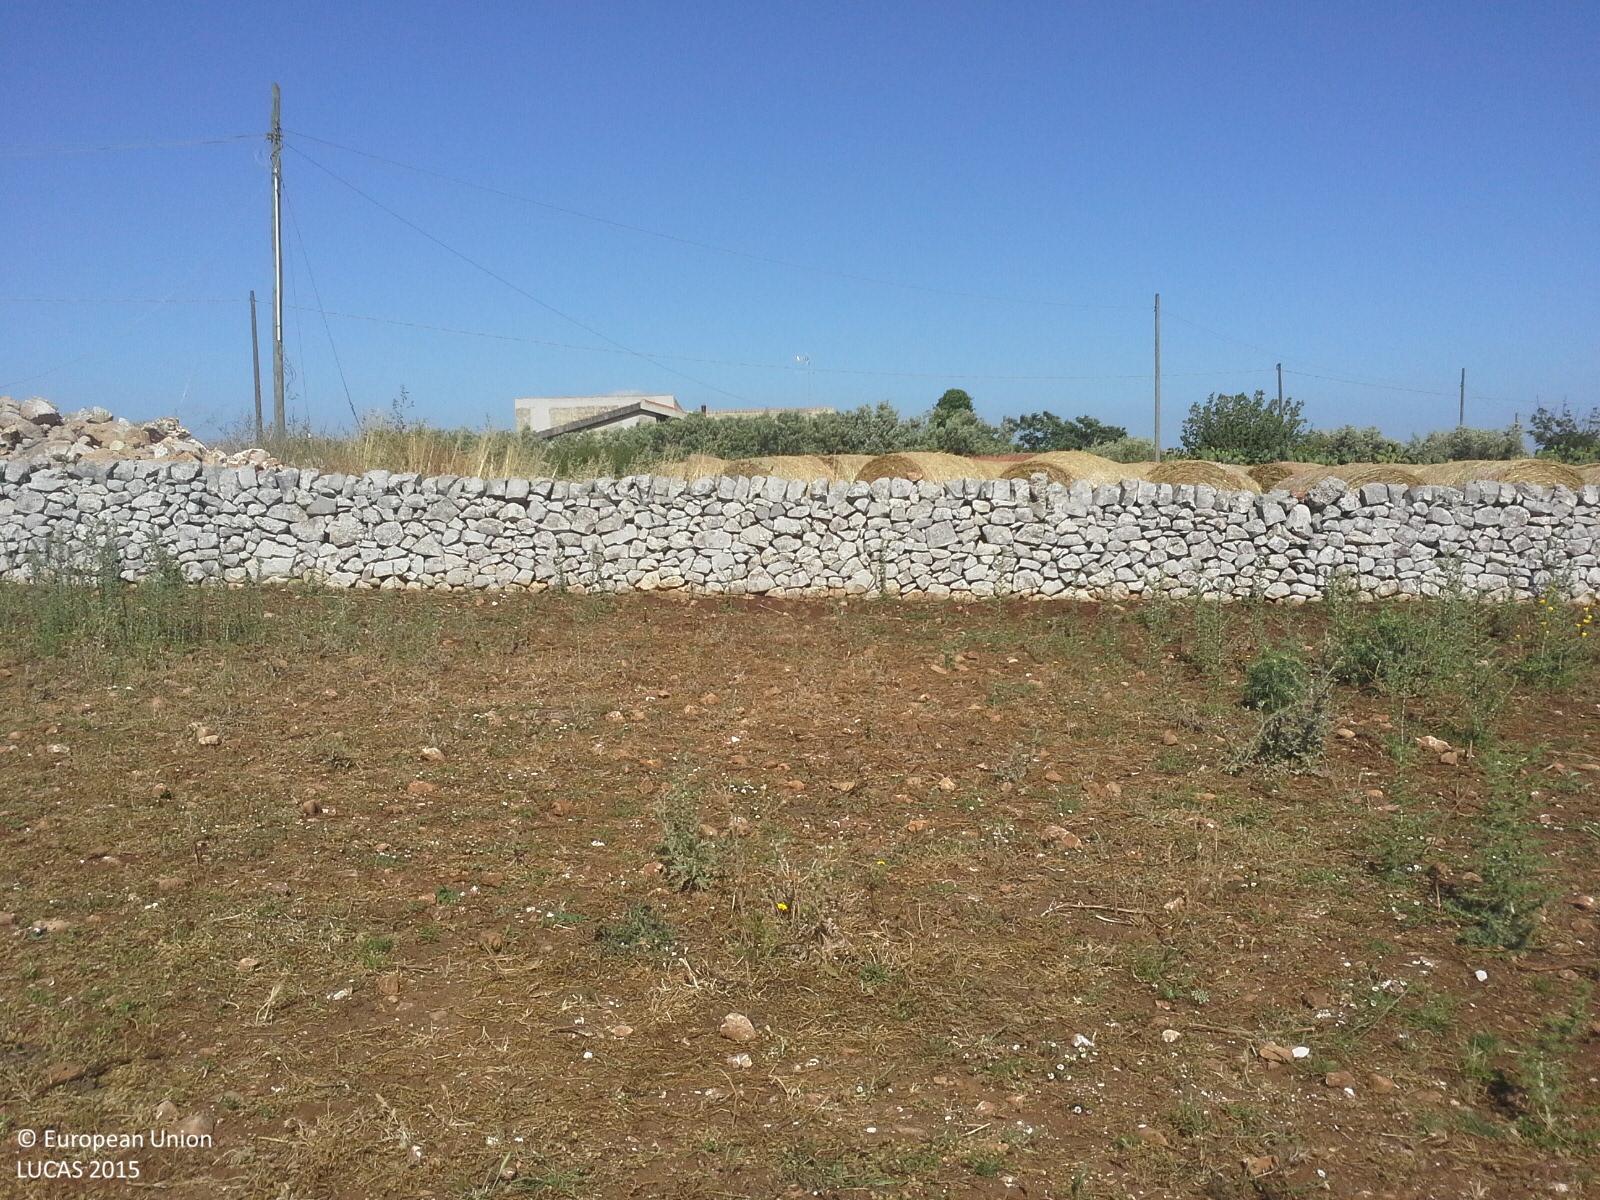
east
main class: Cropland
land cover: Mixed cereals for fodder
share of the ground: > 75 %
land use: Agriculture (excluding fallow land and kitchen gardens)
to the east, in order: Mixed cereals for fodder; Dry stone walls; Rocks and stones; Electric lines; Dry stone walls; Grass margins; Electric lines; Mixed cereals for fodder; Olive groves; Artificial constructions in urban areas; Mixed cereals for fodder; Dry stone walls; Durum wheat; Electric lines; Durum wheat
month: May
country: IT
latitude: 36.8058
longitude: 14.8368
